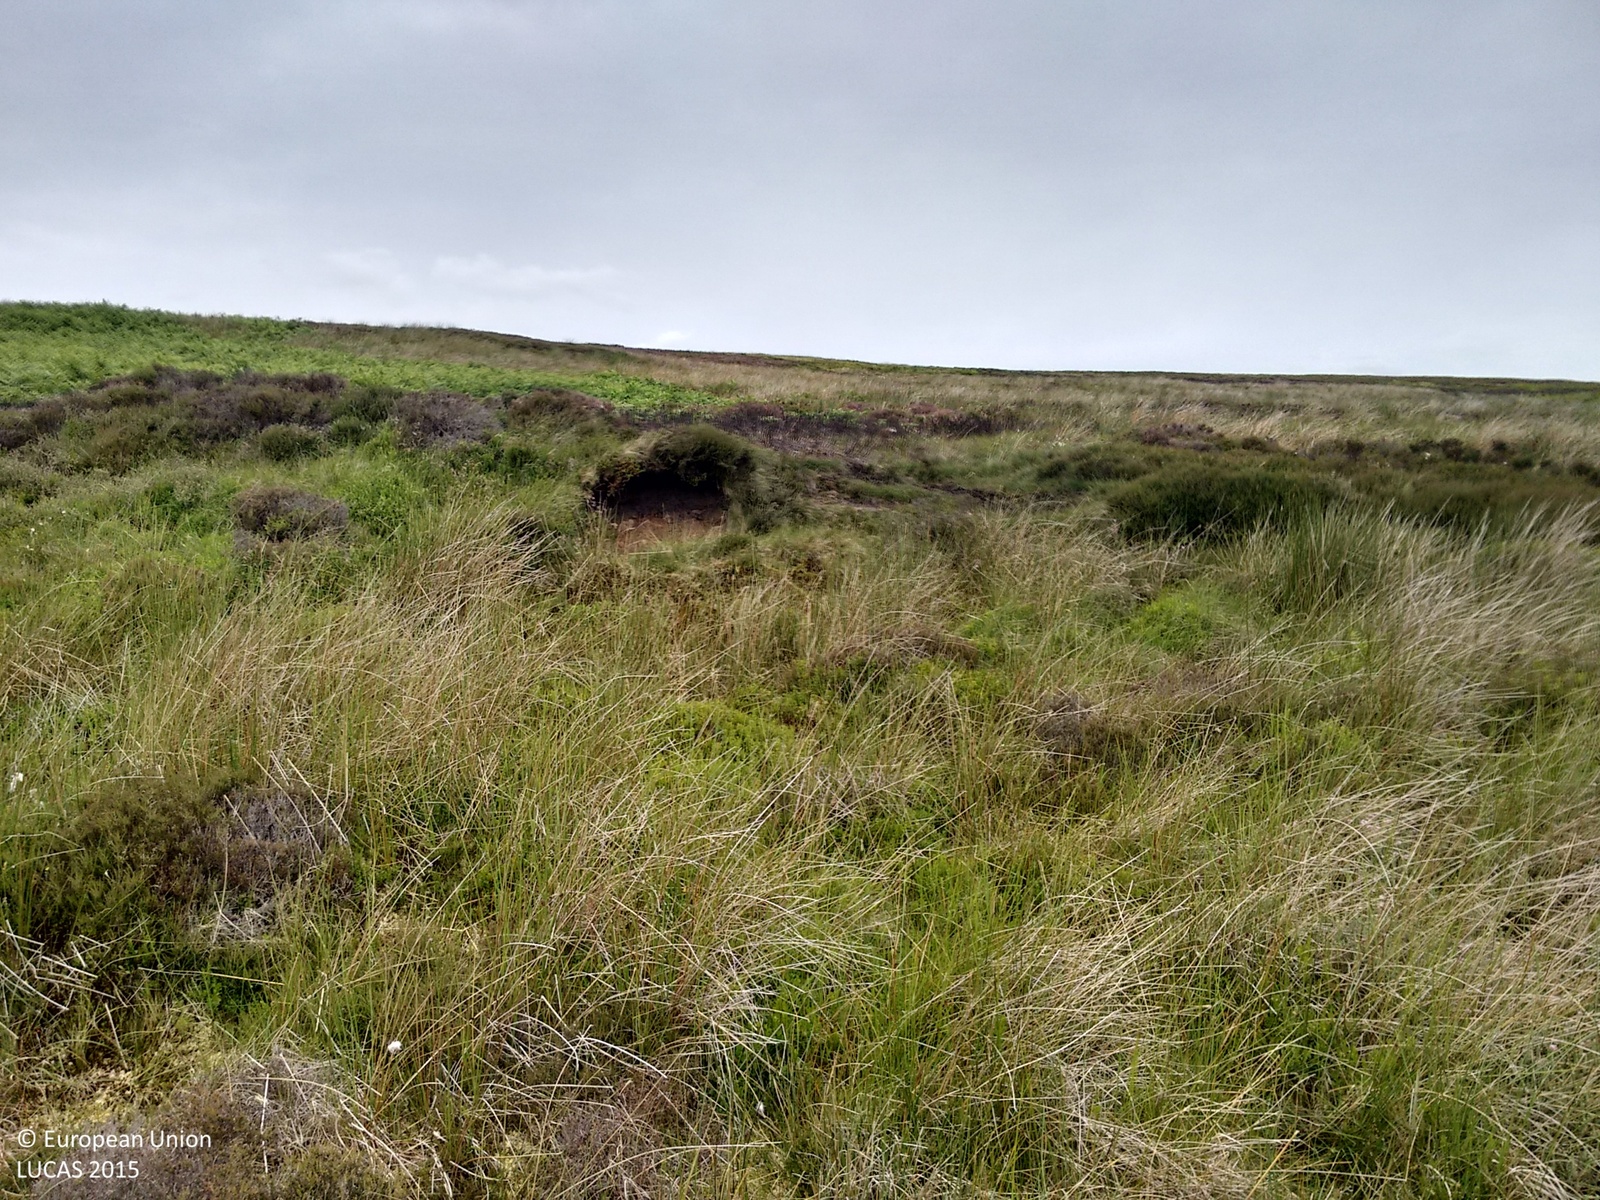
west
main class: Shrubland
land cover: Shrubland without tree cover
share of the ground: > 75 %
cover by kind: shrubs 65 %, herbaceous plants 35 %
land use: Agriculture (excluding fallow land and kitchen gardens)
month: July
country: GB
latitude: 54.4171
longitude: -0.8737
